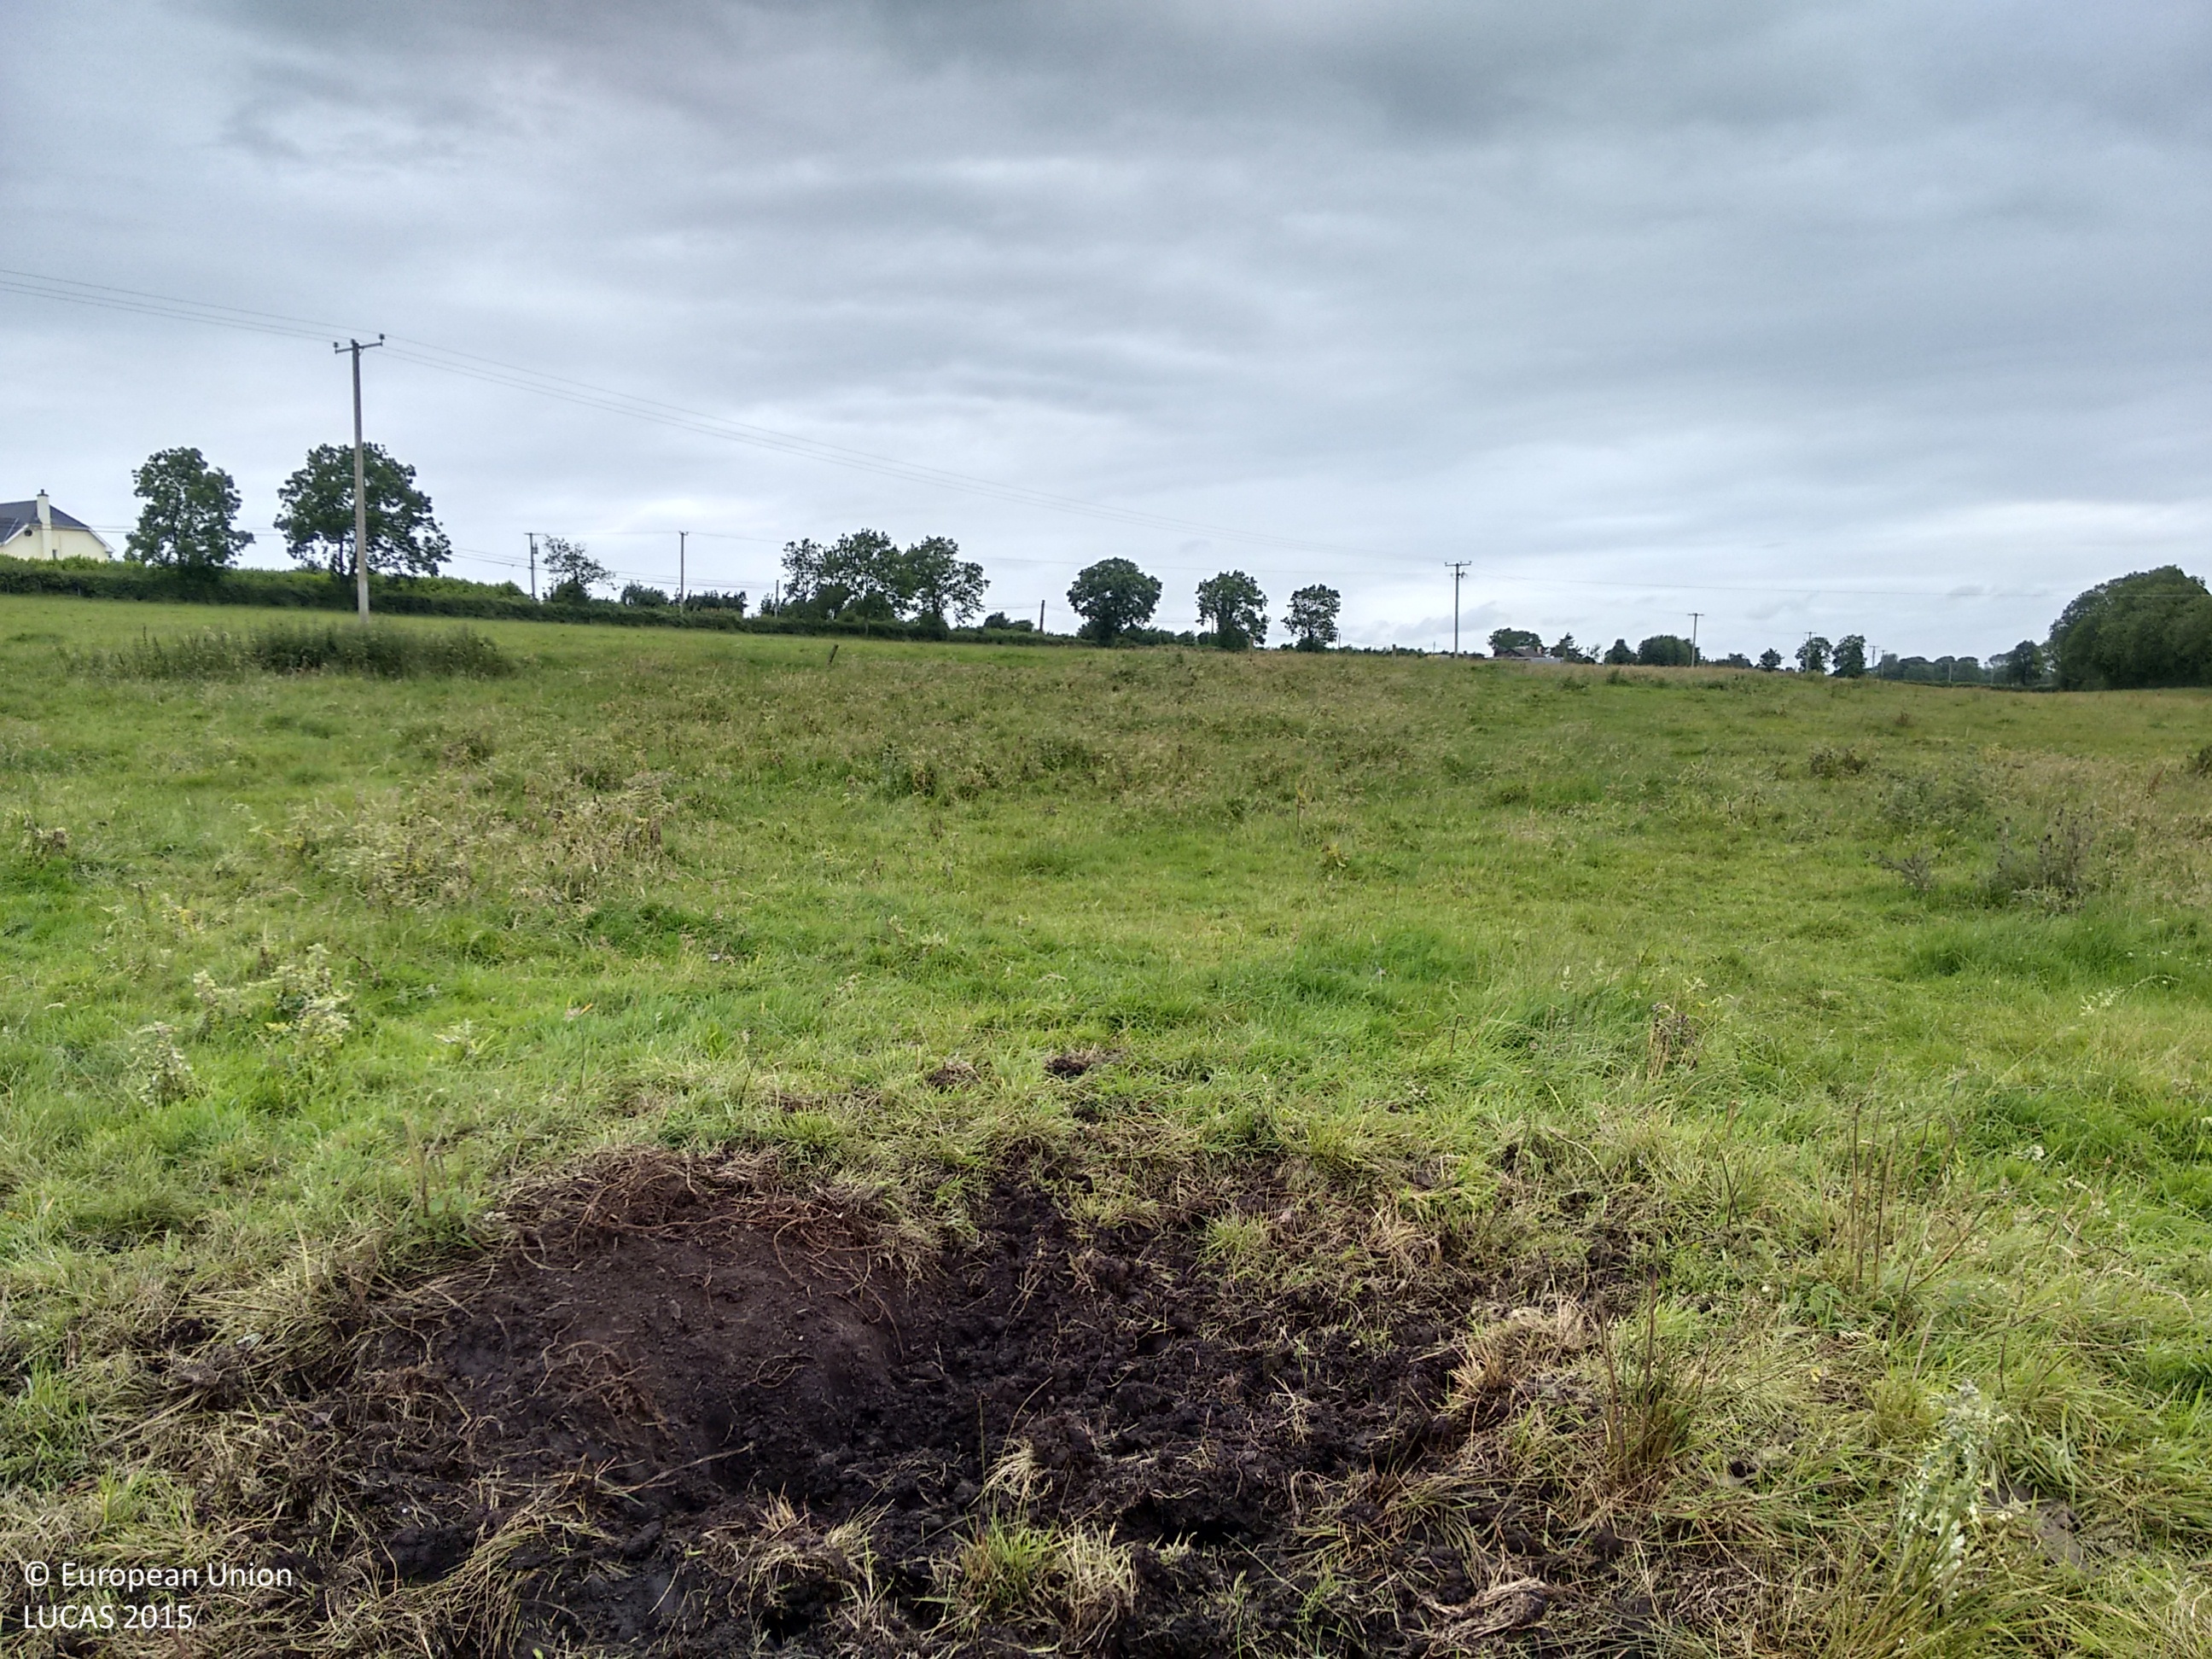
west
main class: Grassland
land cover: Grassland without tree/shrub cover
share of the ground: > 75 %
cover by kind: herbaceous plants 100 %
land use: Agriculture (excluding fallow land and kitchen gardens)
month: July
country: IE
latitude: 53.6325
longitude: -7.8167
